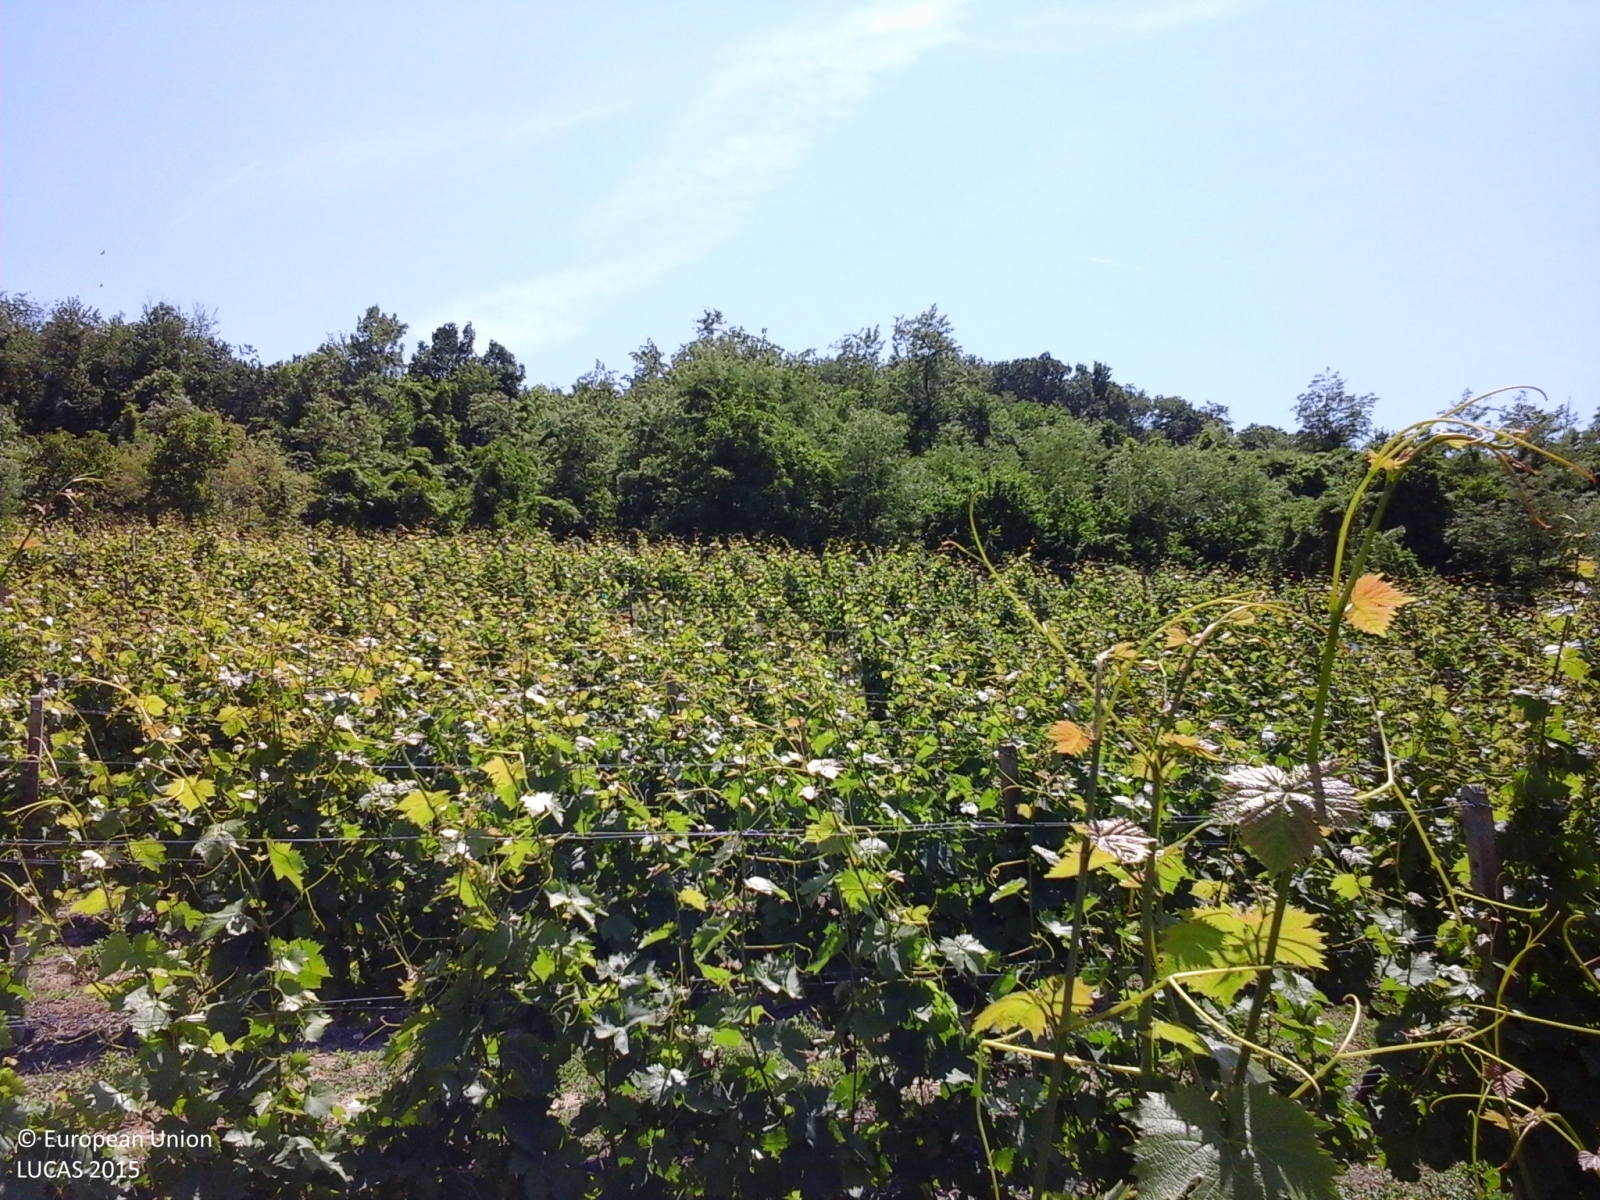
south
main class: Cropland
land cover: Vineyards
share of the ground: 50 - 75 %
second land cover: Grassland without tree/shrub cover
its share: > 75 %
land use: Agriculture (excluding fallow land and kitchen gardens)
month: June
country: IT
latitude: 44.6245
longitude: 8.2517
